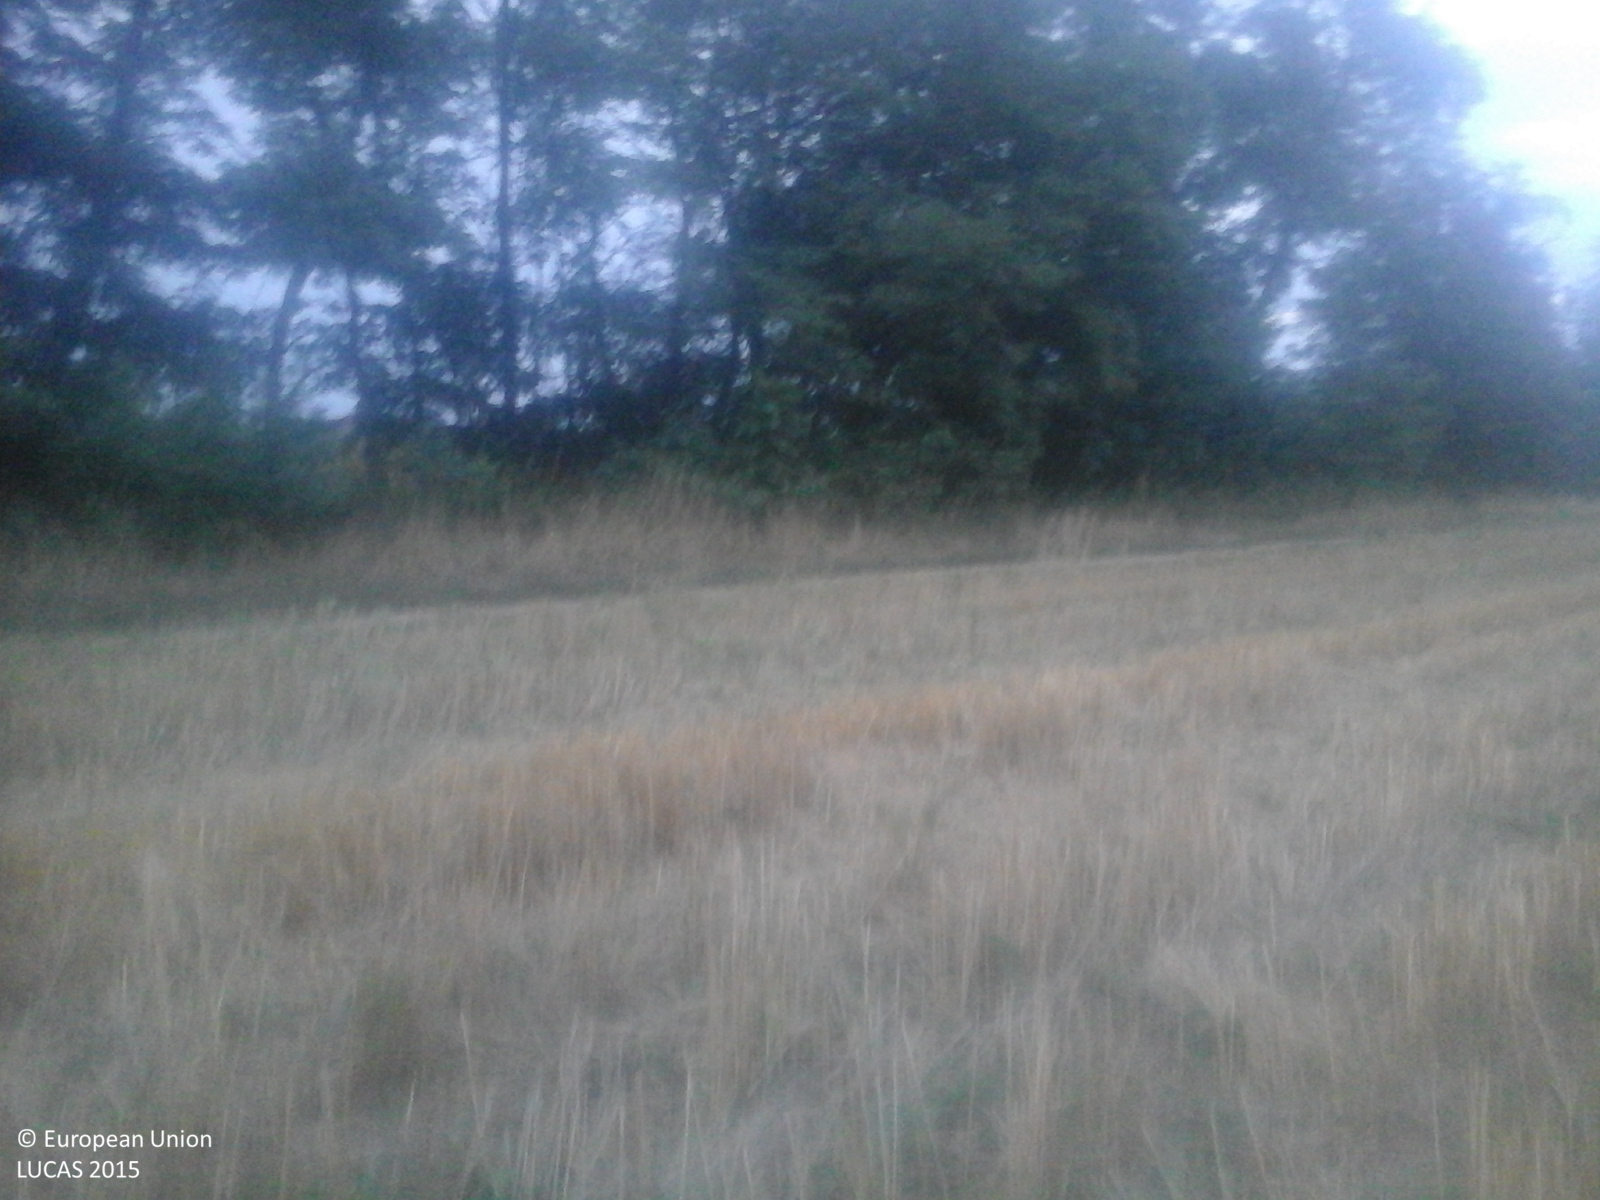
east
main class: Cropland
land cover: Durum wheat
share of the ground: > 75 %
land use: Agriculture (excluding fallow land and kitchen gardens)
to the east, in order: Durum wheat; Tracks; Shruby margins; Ditches and canals; Abandoned hedges; Lucerne; Maize; Grassland without tree/shrub cover; Artificial constructions in urban areas; Maize; Artificial constructions in urban areas
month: September
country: RO
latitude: 47.8123
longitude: 22.7085
